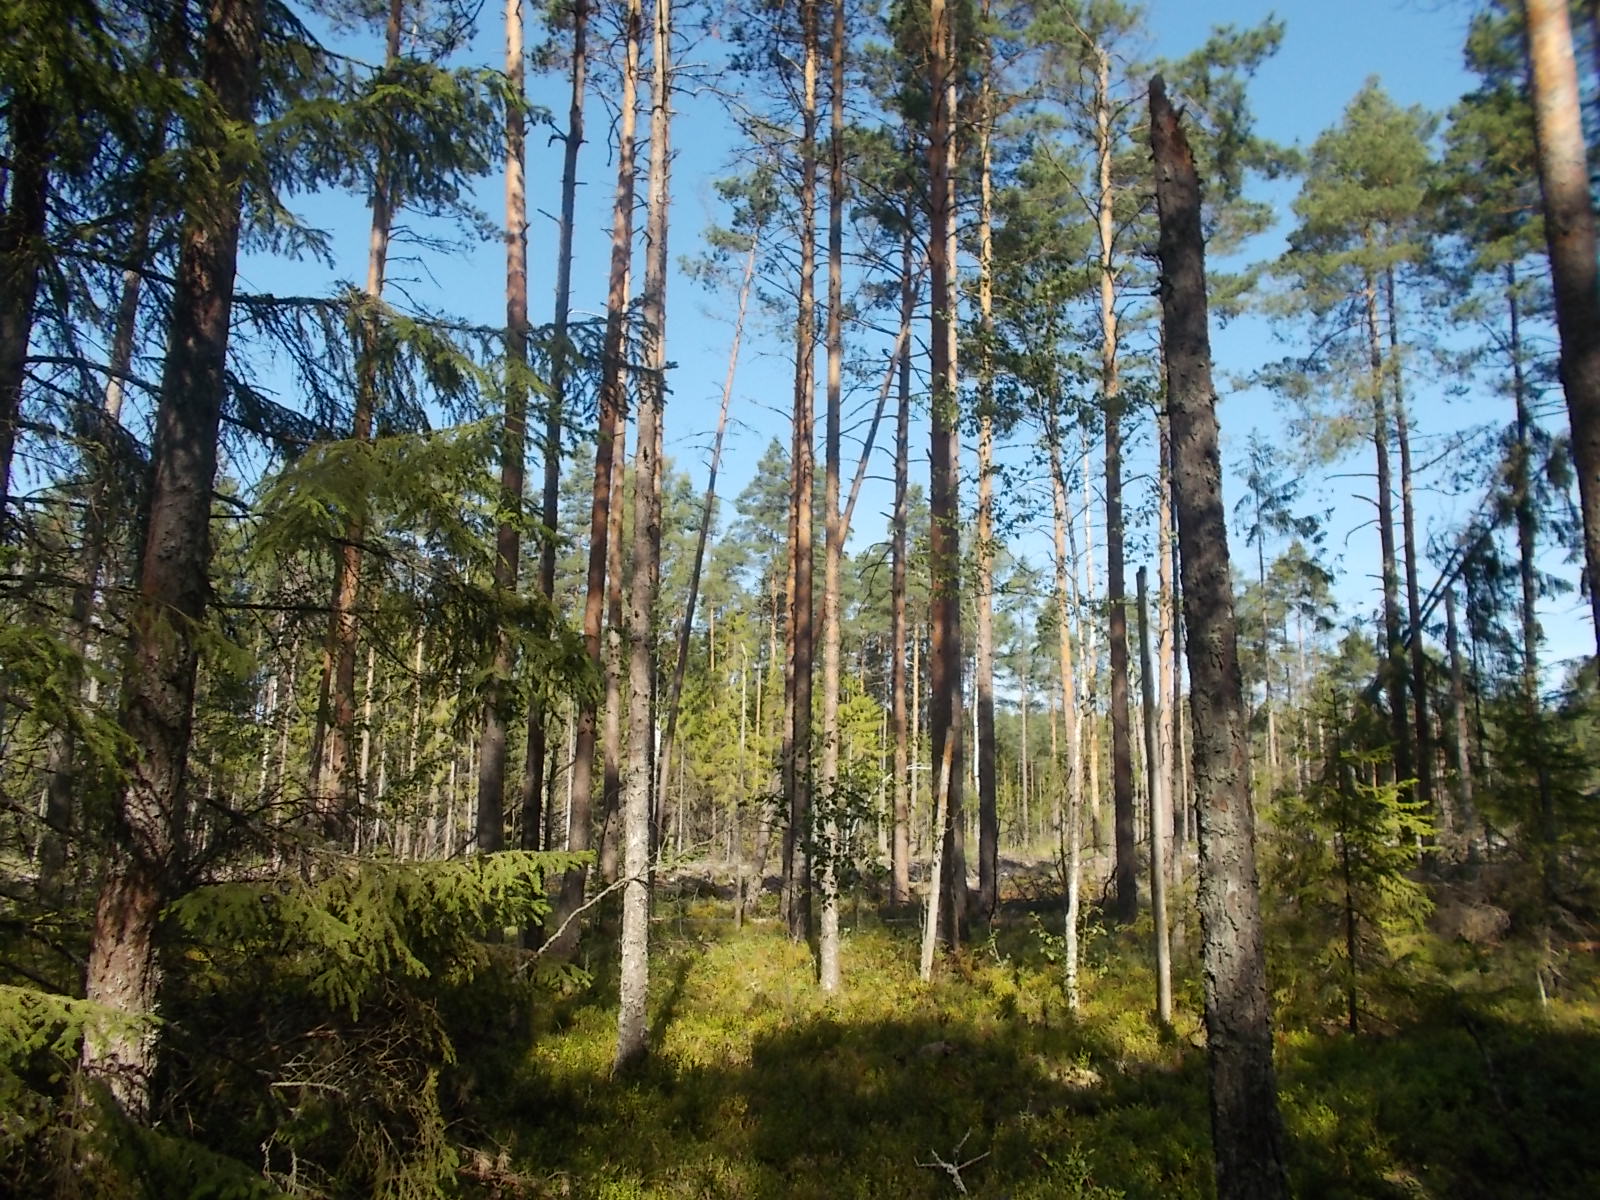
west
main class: Woodland
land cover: Other coniferous woodland
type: hemiboreal forest and nemoral coniferous forest and mixed broadleaved-coniferous forest
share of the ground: 50 - 75 %
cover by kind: coniferous forest trees 60 %, broadleaved forest trees 10 %, shrubs 10 %, herbaceous plants 10 %, lichens and mosses 10 %
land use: Forestry
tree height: > 5 m
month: August
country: LV
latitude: 57.0631
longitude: 21.9693
